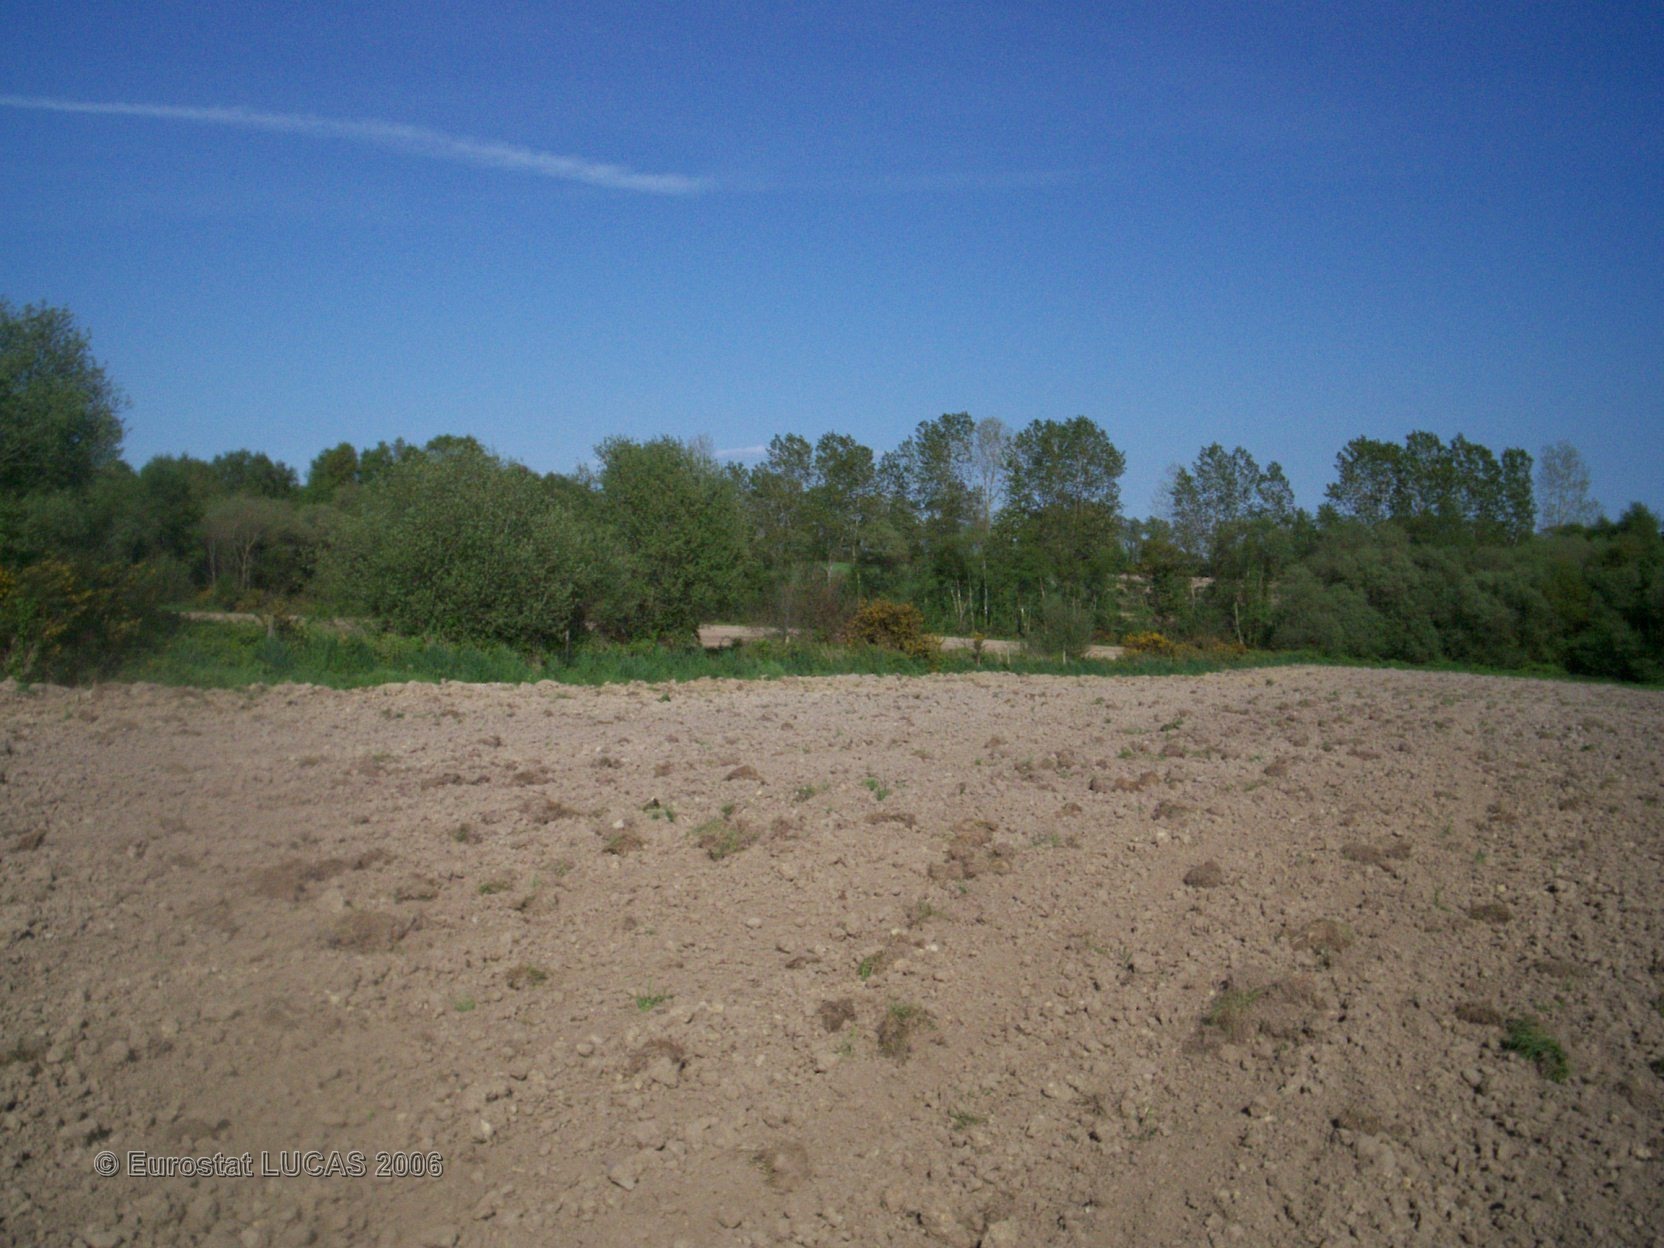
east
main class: Cropland
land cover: Maize
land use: Agriculture (excluding fallow land and kitchen gardens)
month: May
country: FR
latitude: 48.0059
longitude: -2.9210
